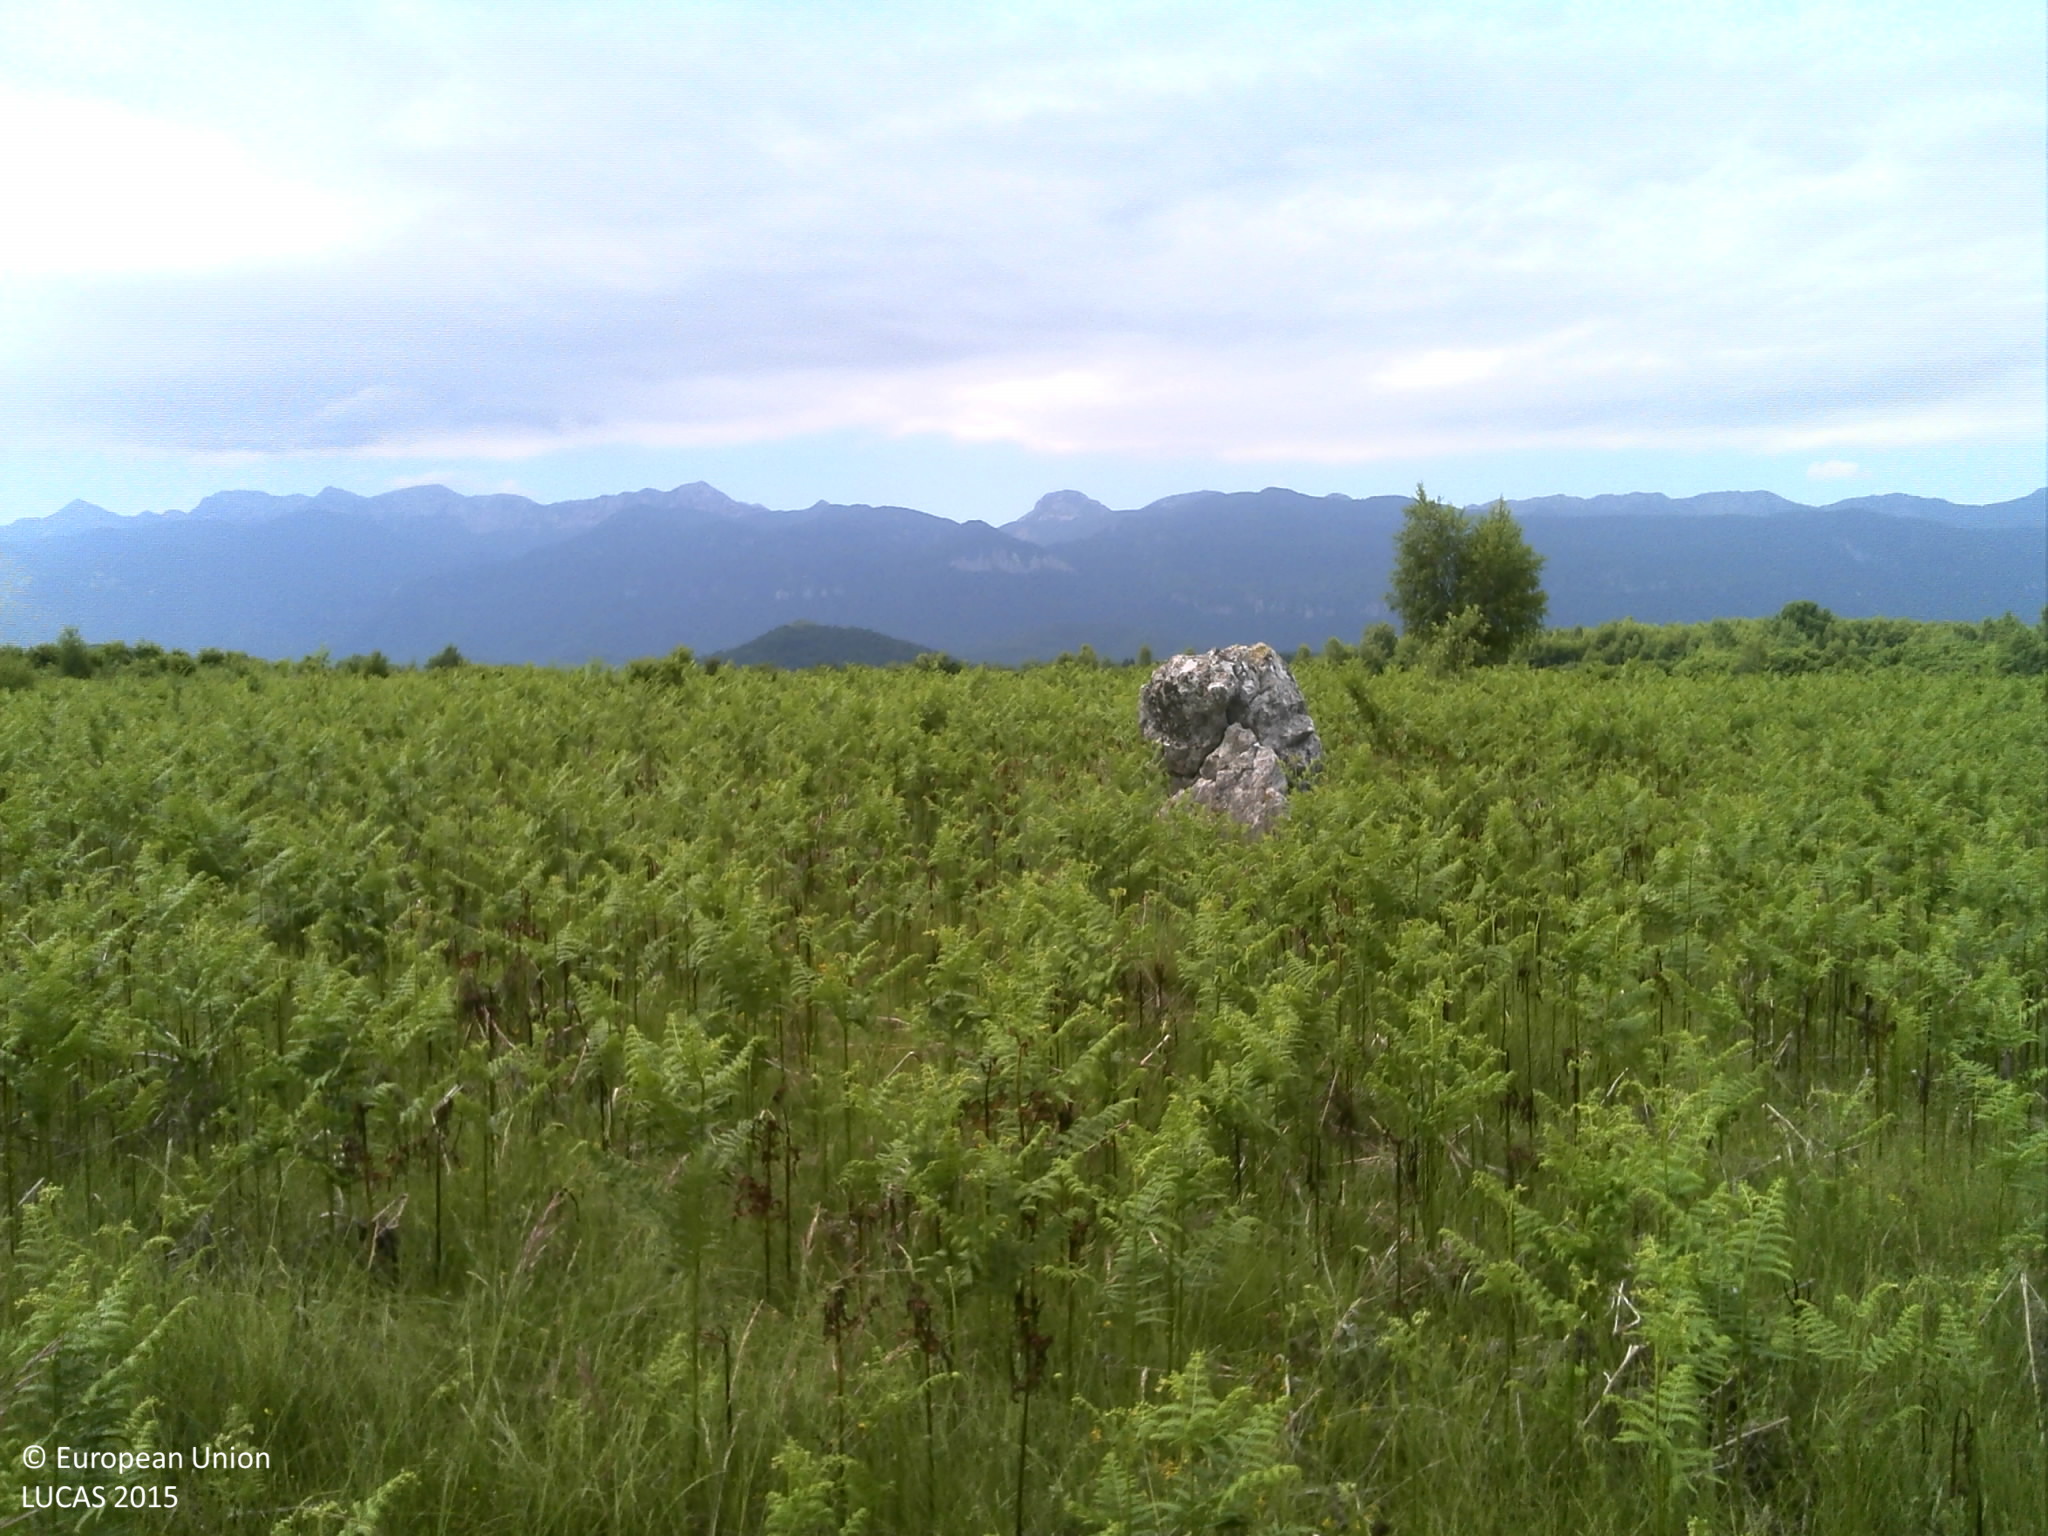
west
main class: Grassland
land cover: Spontaneously vegetated surfaces
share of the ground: > 75 %
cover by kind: herbaceous plants 90 %, shrubs 5 %, consolidated bare surface 5 %
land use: Semi-natural and natural areas not in use
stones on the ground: < 10 %
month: June
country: HR
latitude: 44.4738
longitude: 15.5372
